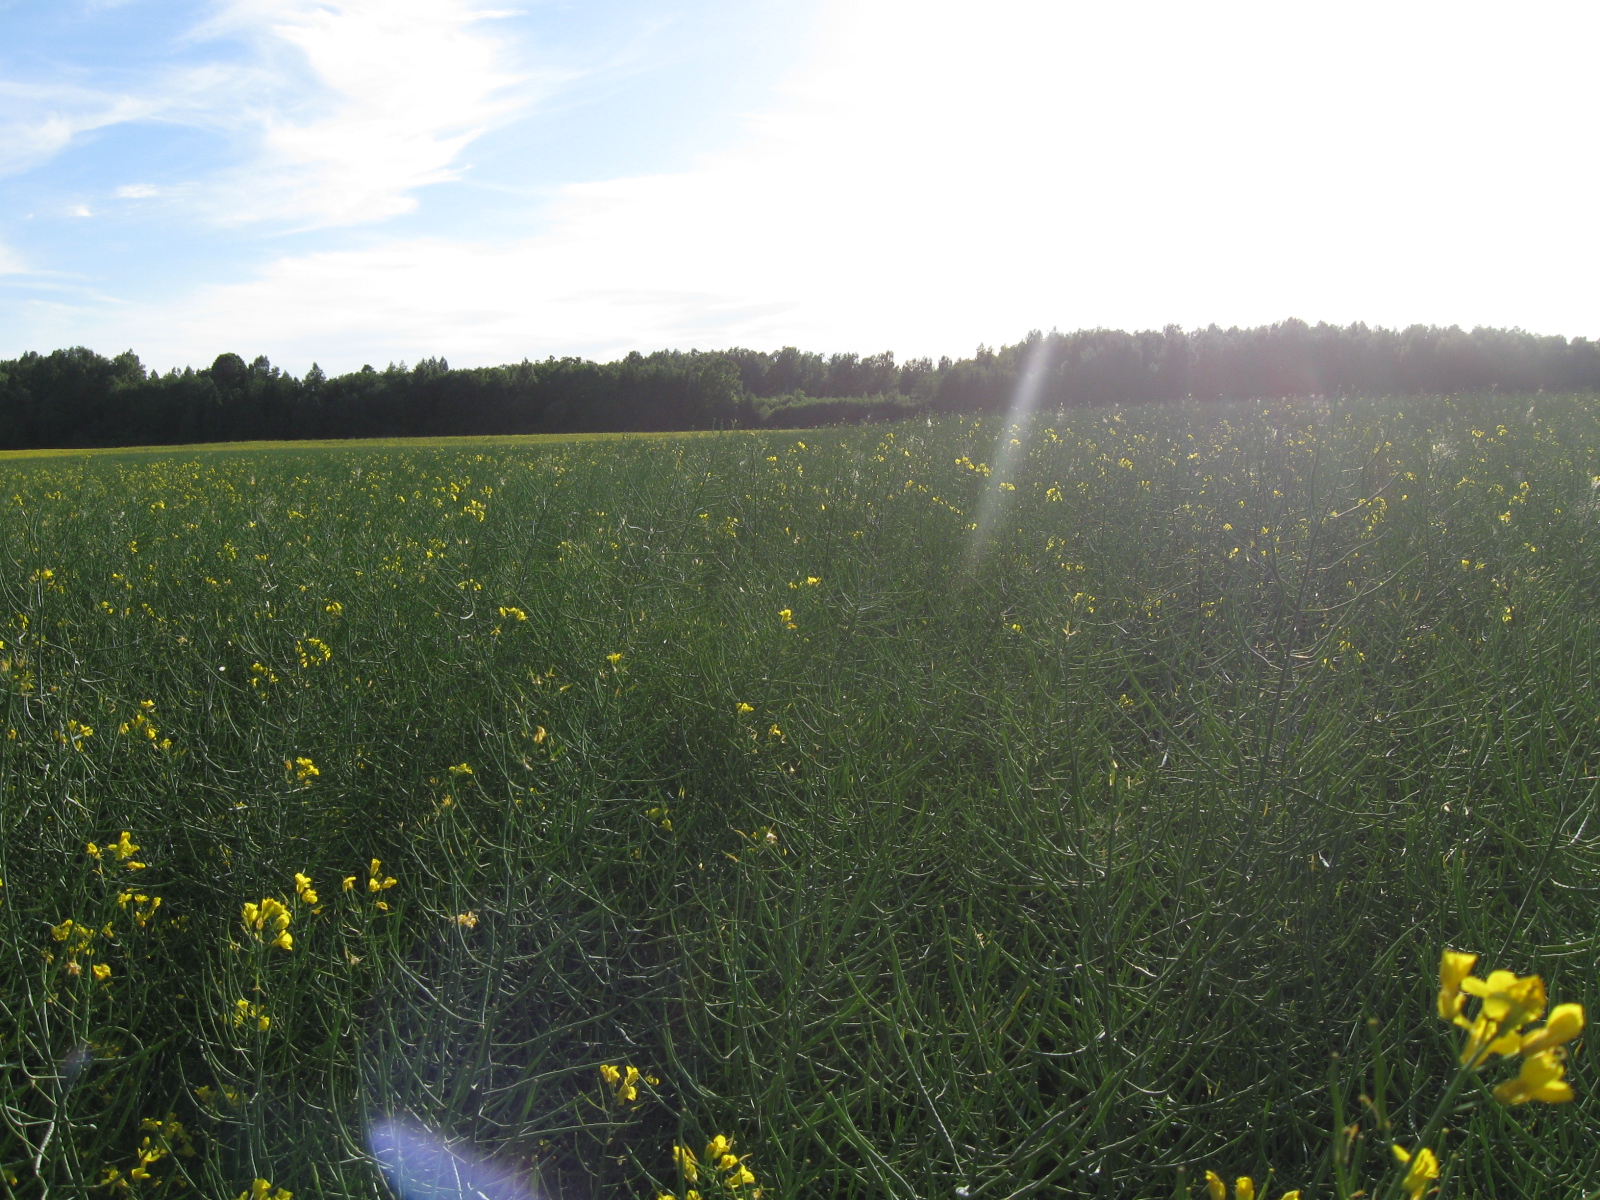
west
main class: Cropland
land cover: Rape and turnip rape
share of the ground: > 75 %
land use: Agriculture (excluding fallow land and kitchen gardens)
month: June
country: LT
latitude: 55.0453
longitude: 24.0361
